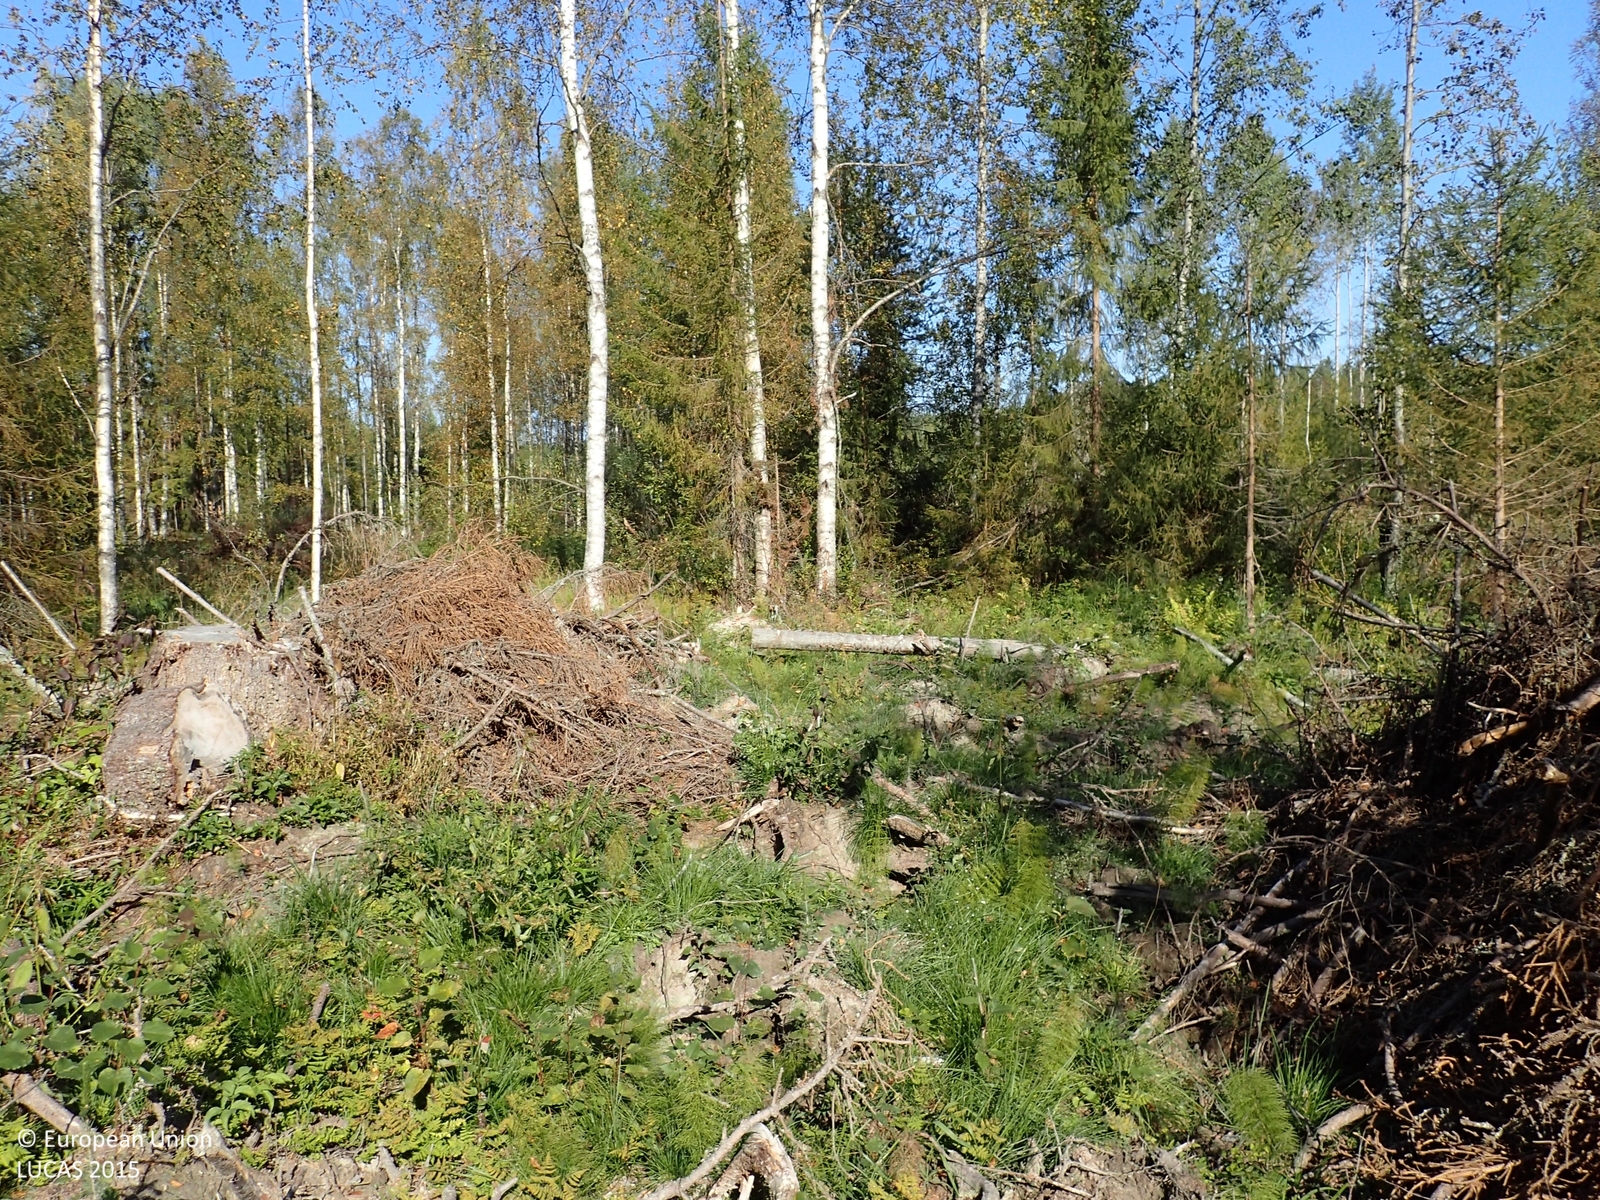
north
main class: Grassland
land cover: Grassland with sparse tree/shrub cover
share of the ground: > 75 %
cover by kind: herbaceous plants 90 %, broadleaved forest trees 5 %, unconsolidated bare surface 5 %
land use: Forestry
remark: Clear cut
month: September
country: FI
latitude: 62.9446
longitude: 25.3365
